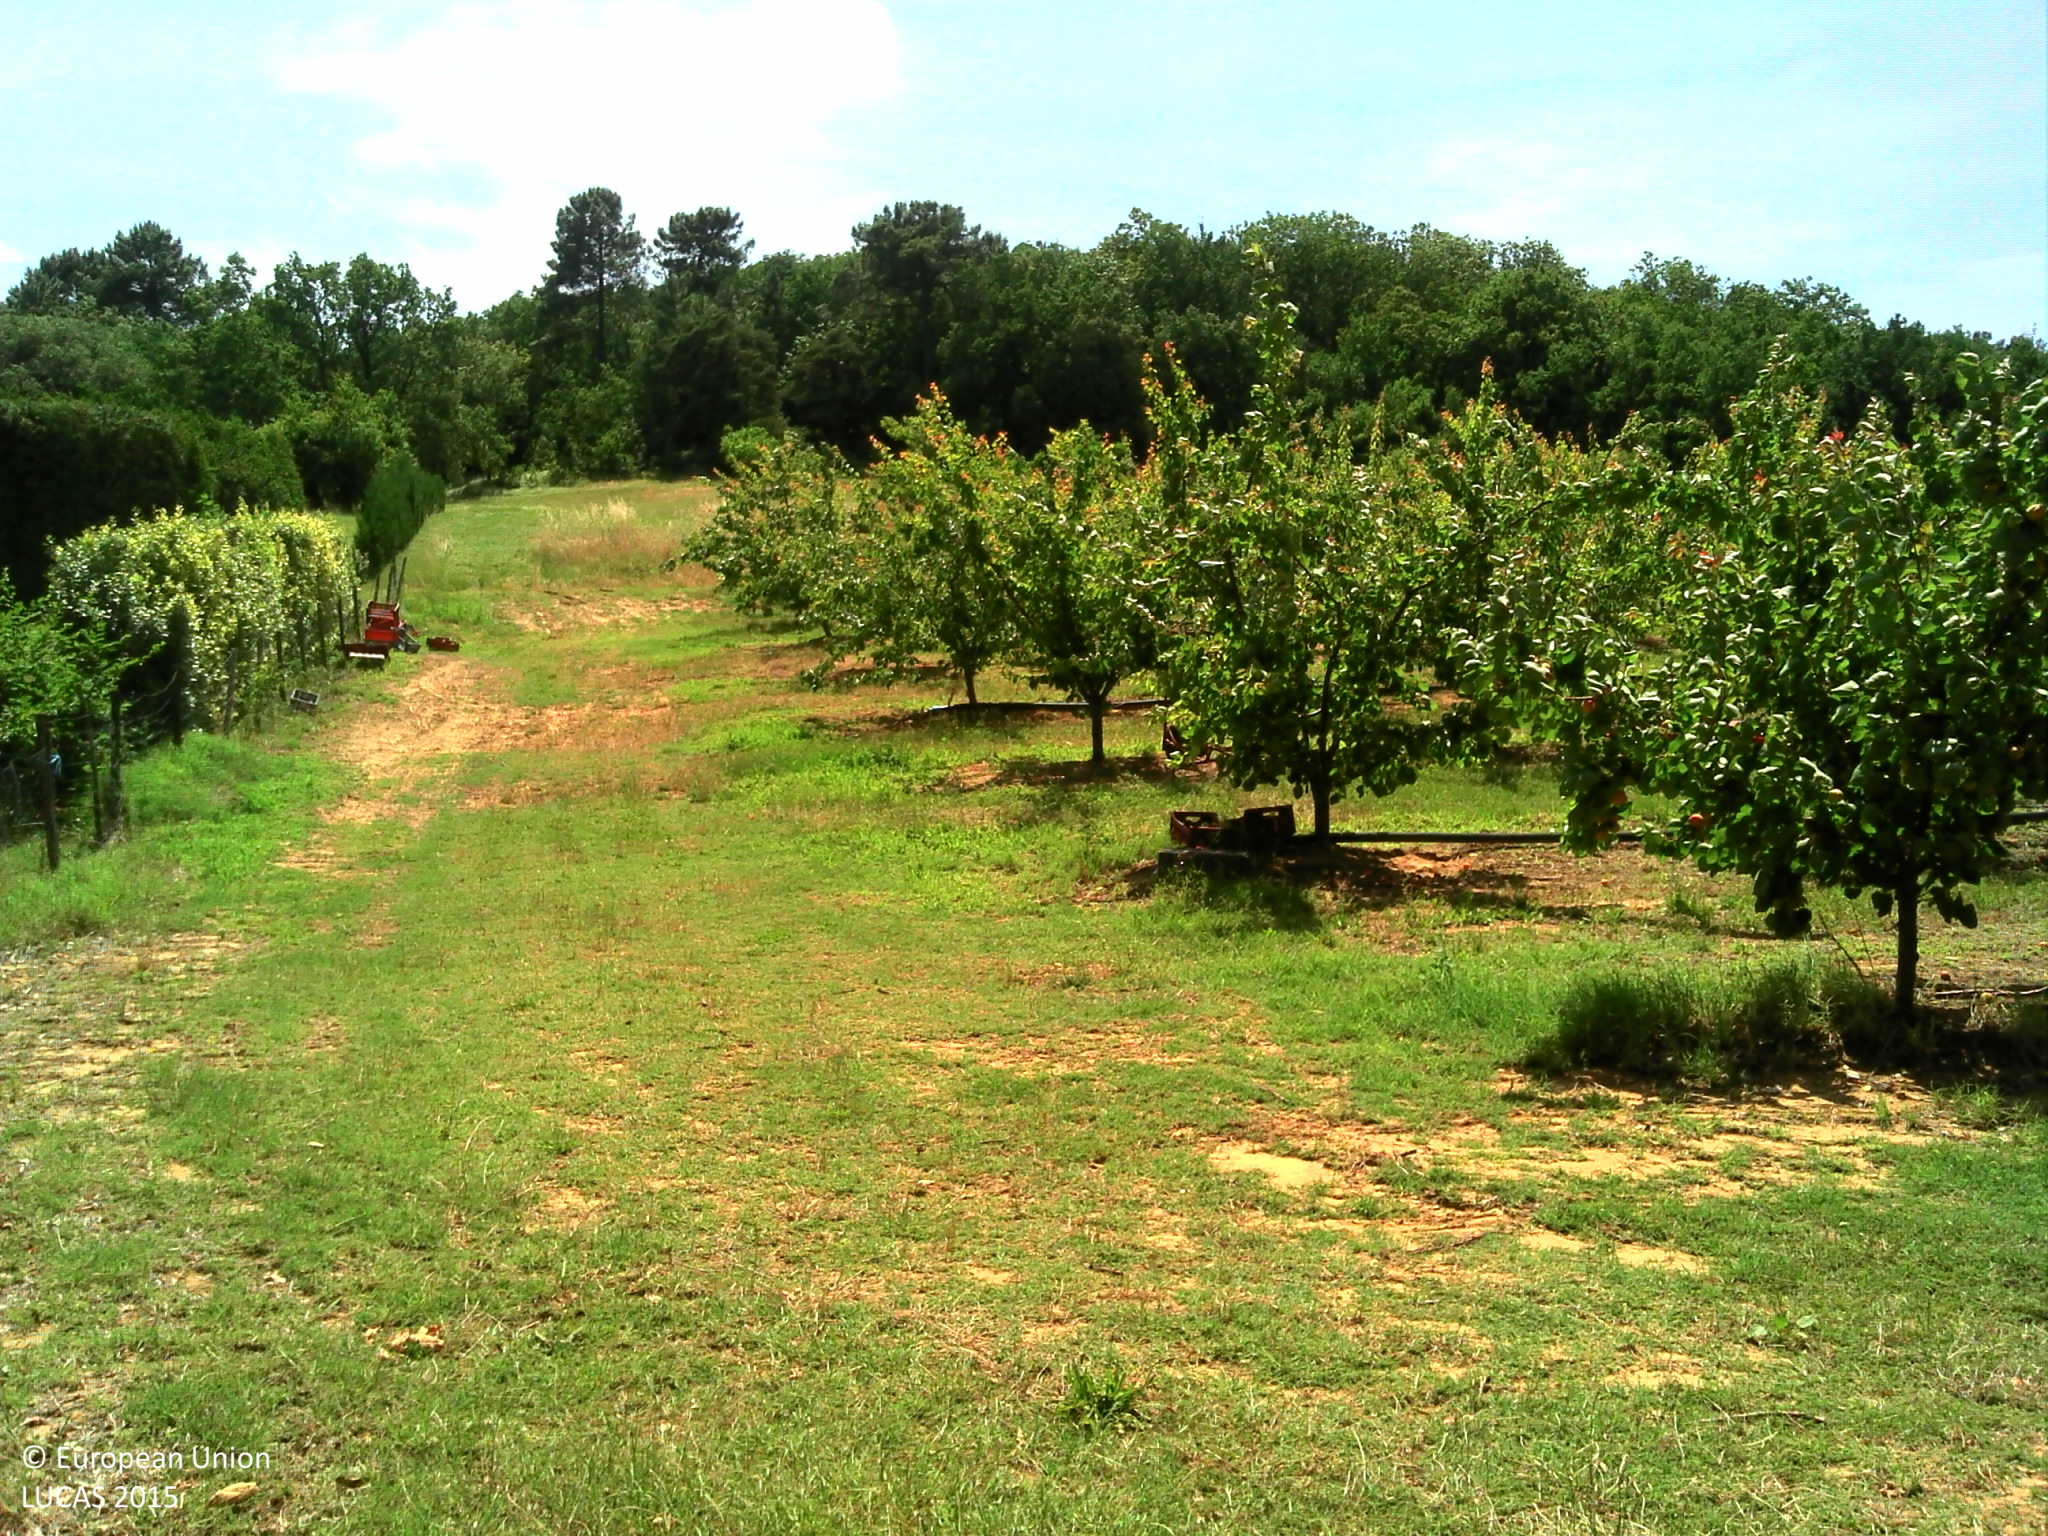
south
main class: Woodland
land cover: Broadleaved woodland
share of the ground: > 75 %
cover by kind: broadleaved forest trees 95 %, herbaceous plants 5 %
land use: Semi-natural and natural areas not in use
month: June
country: FR
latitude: 44.8410
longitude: 4.9330
